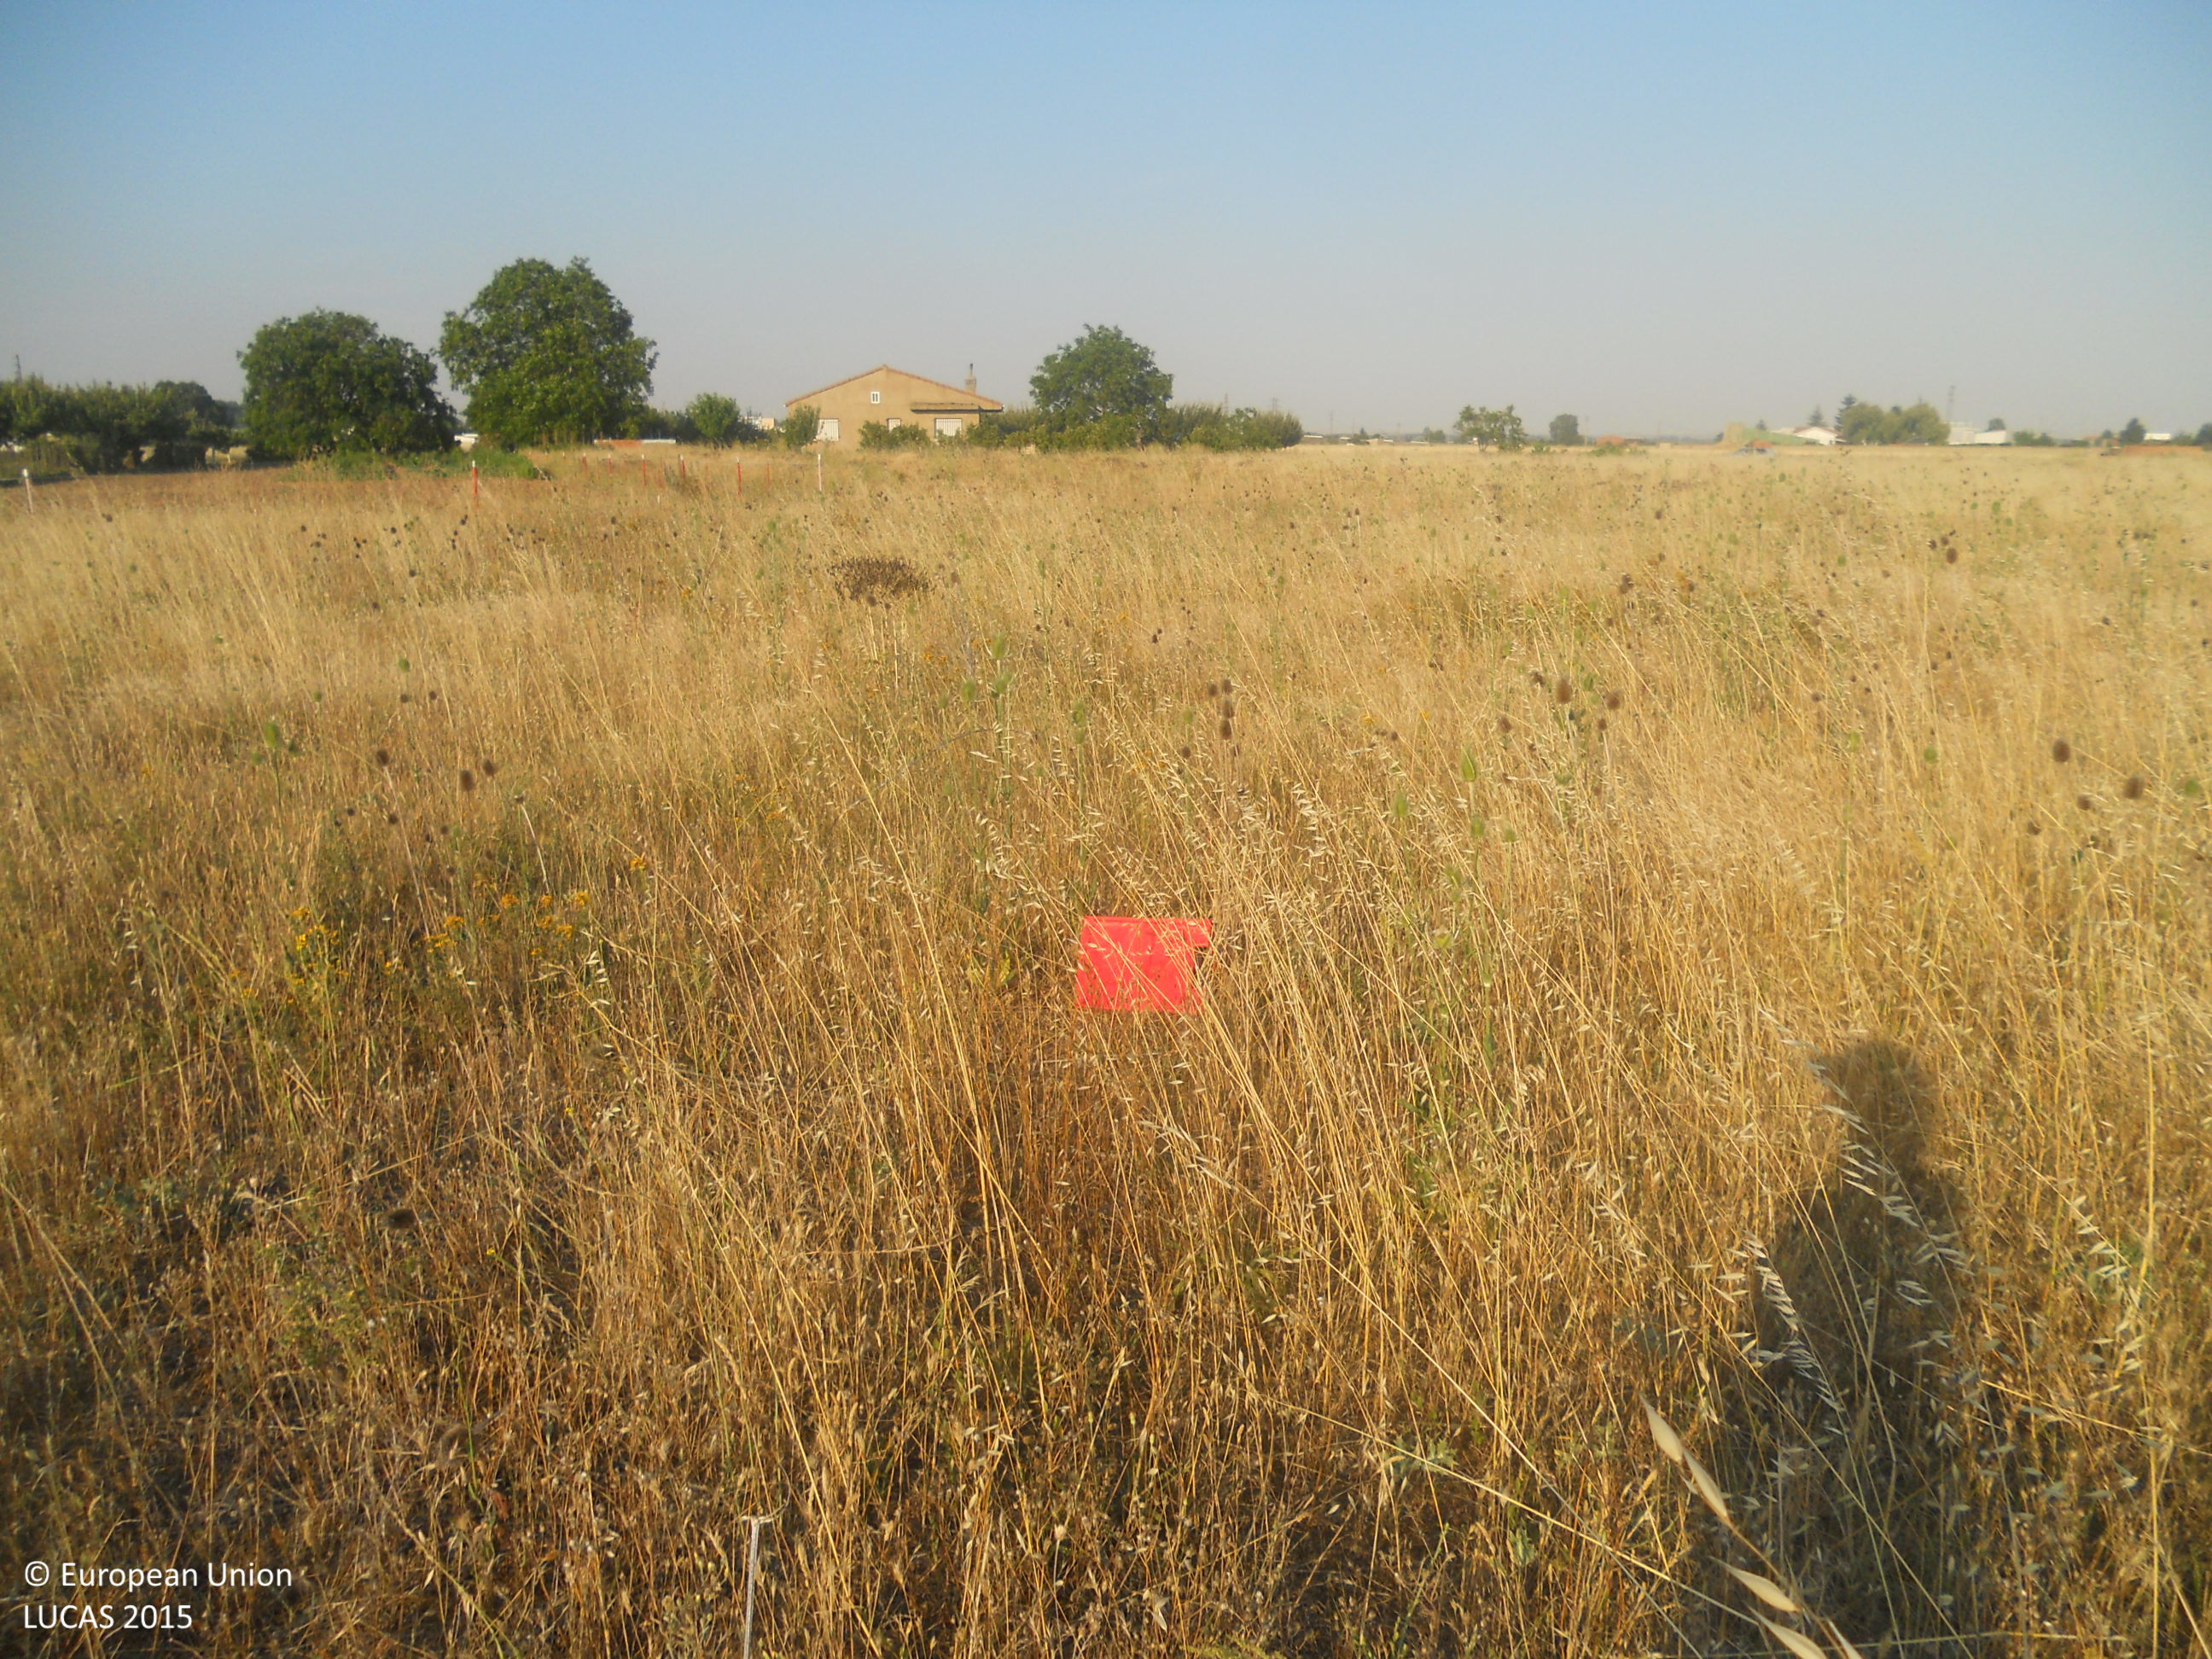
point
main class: Grassland
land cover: Grassland without tree/shrub cover
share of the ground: > 75 %
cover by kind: herbaceous plants 100 %
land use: Agriculture (excluding fallow land and kitchen gardens)
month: July
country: ES
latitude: 42.5209
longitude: -5.5923
